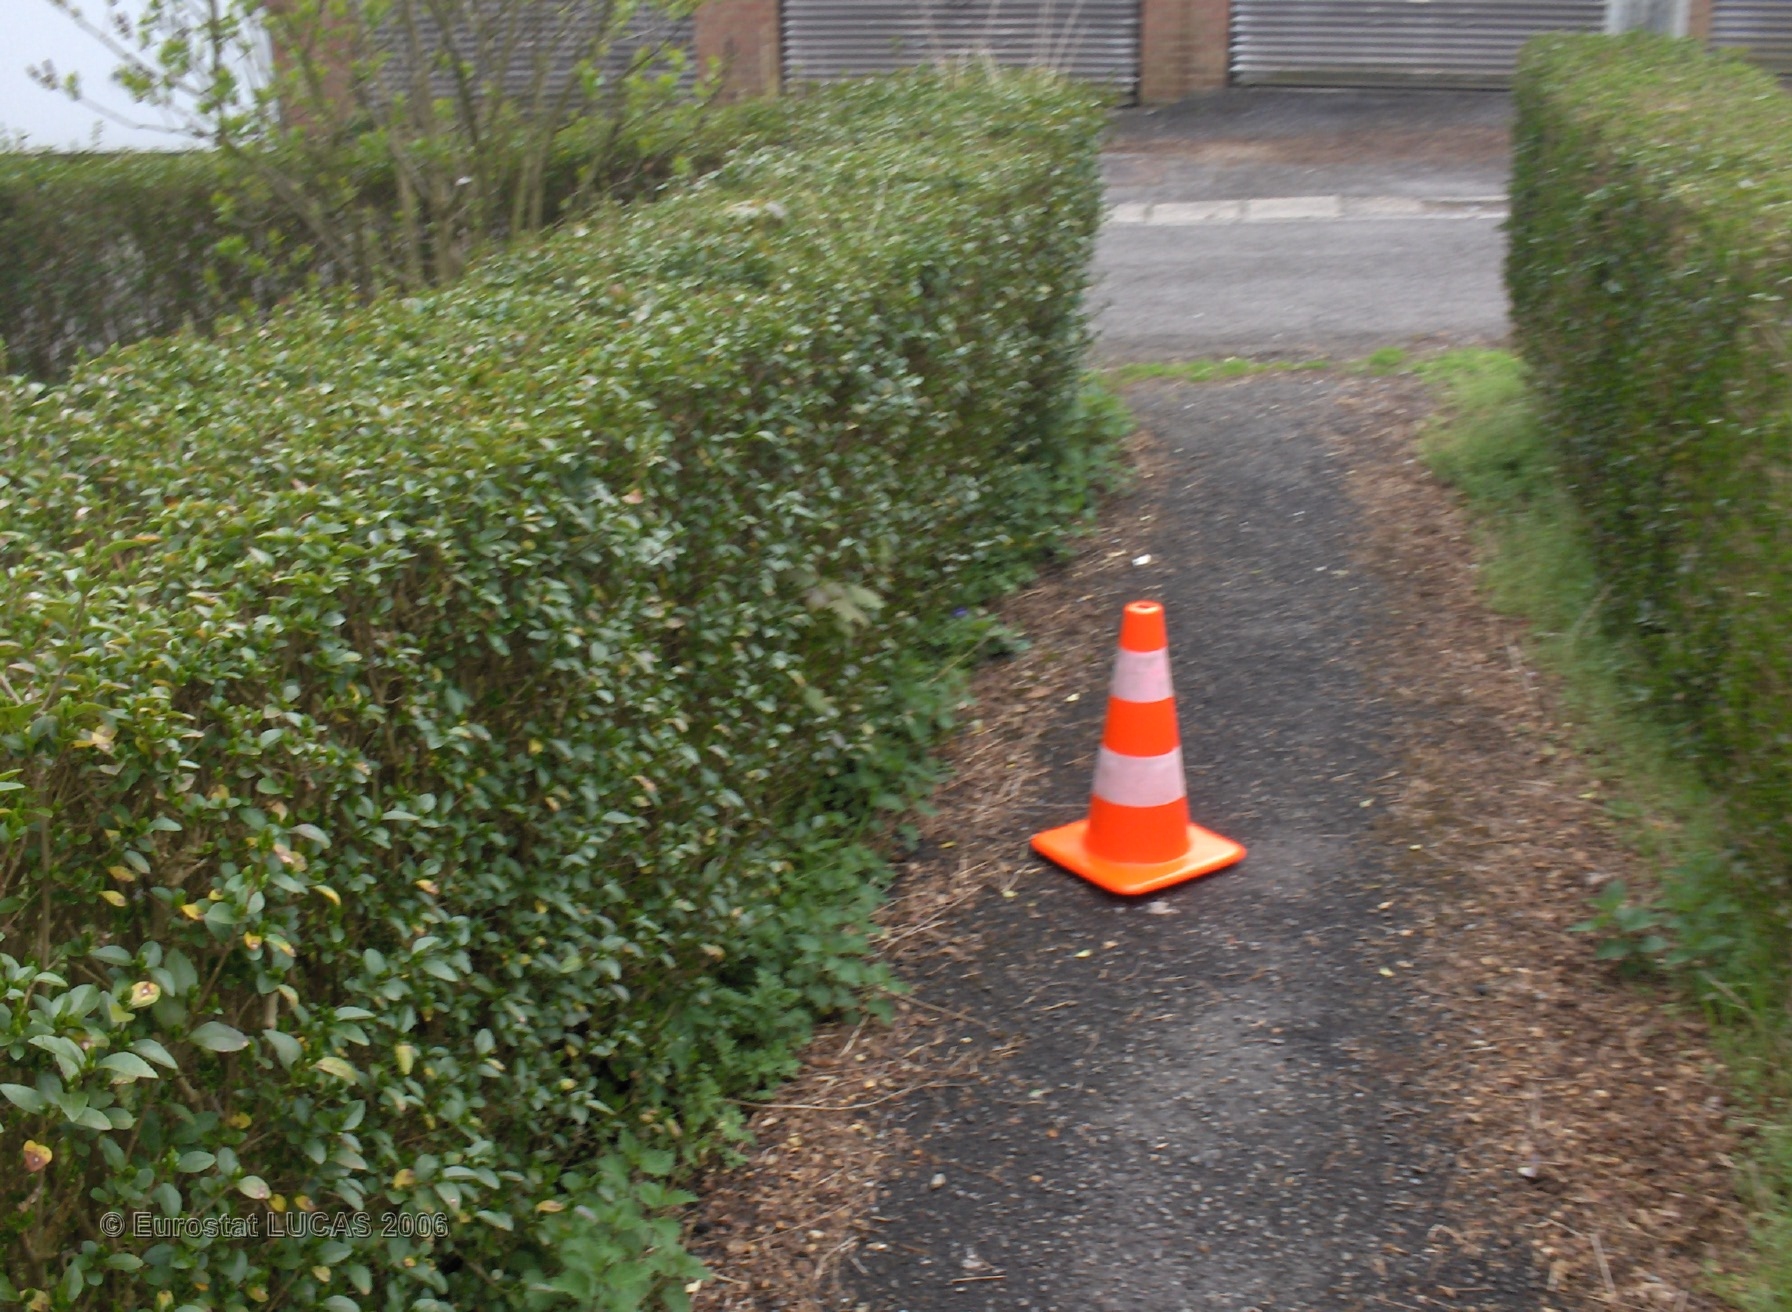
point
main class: Grassland
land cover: Grassland with sparse tree/shrub cover
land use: Residential
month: April
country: BE
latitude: 50.3593
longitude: 4.5280
